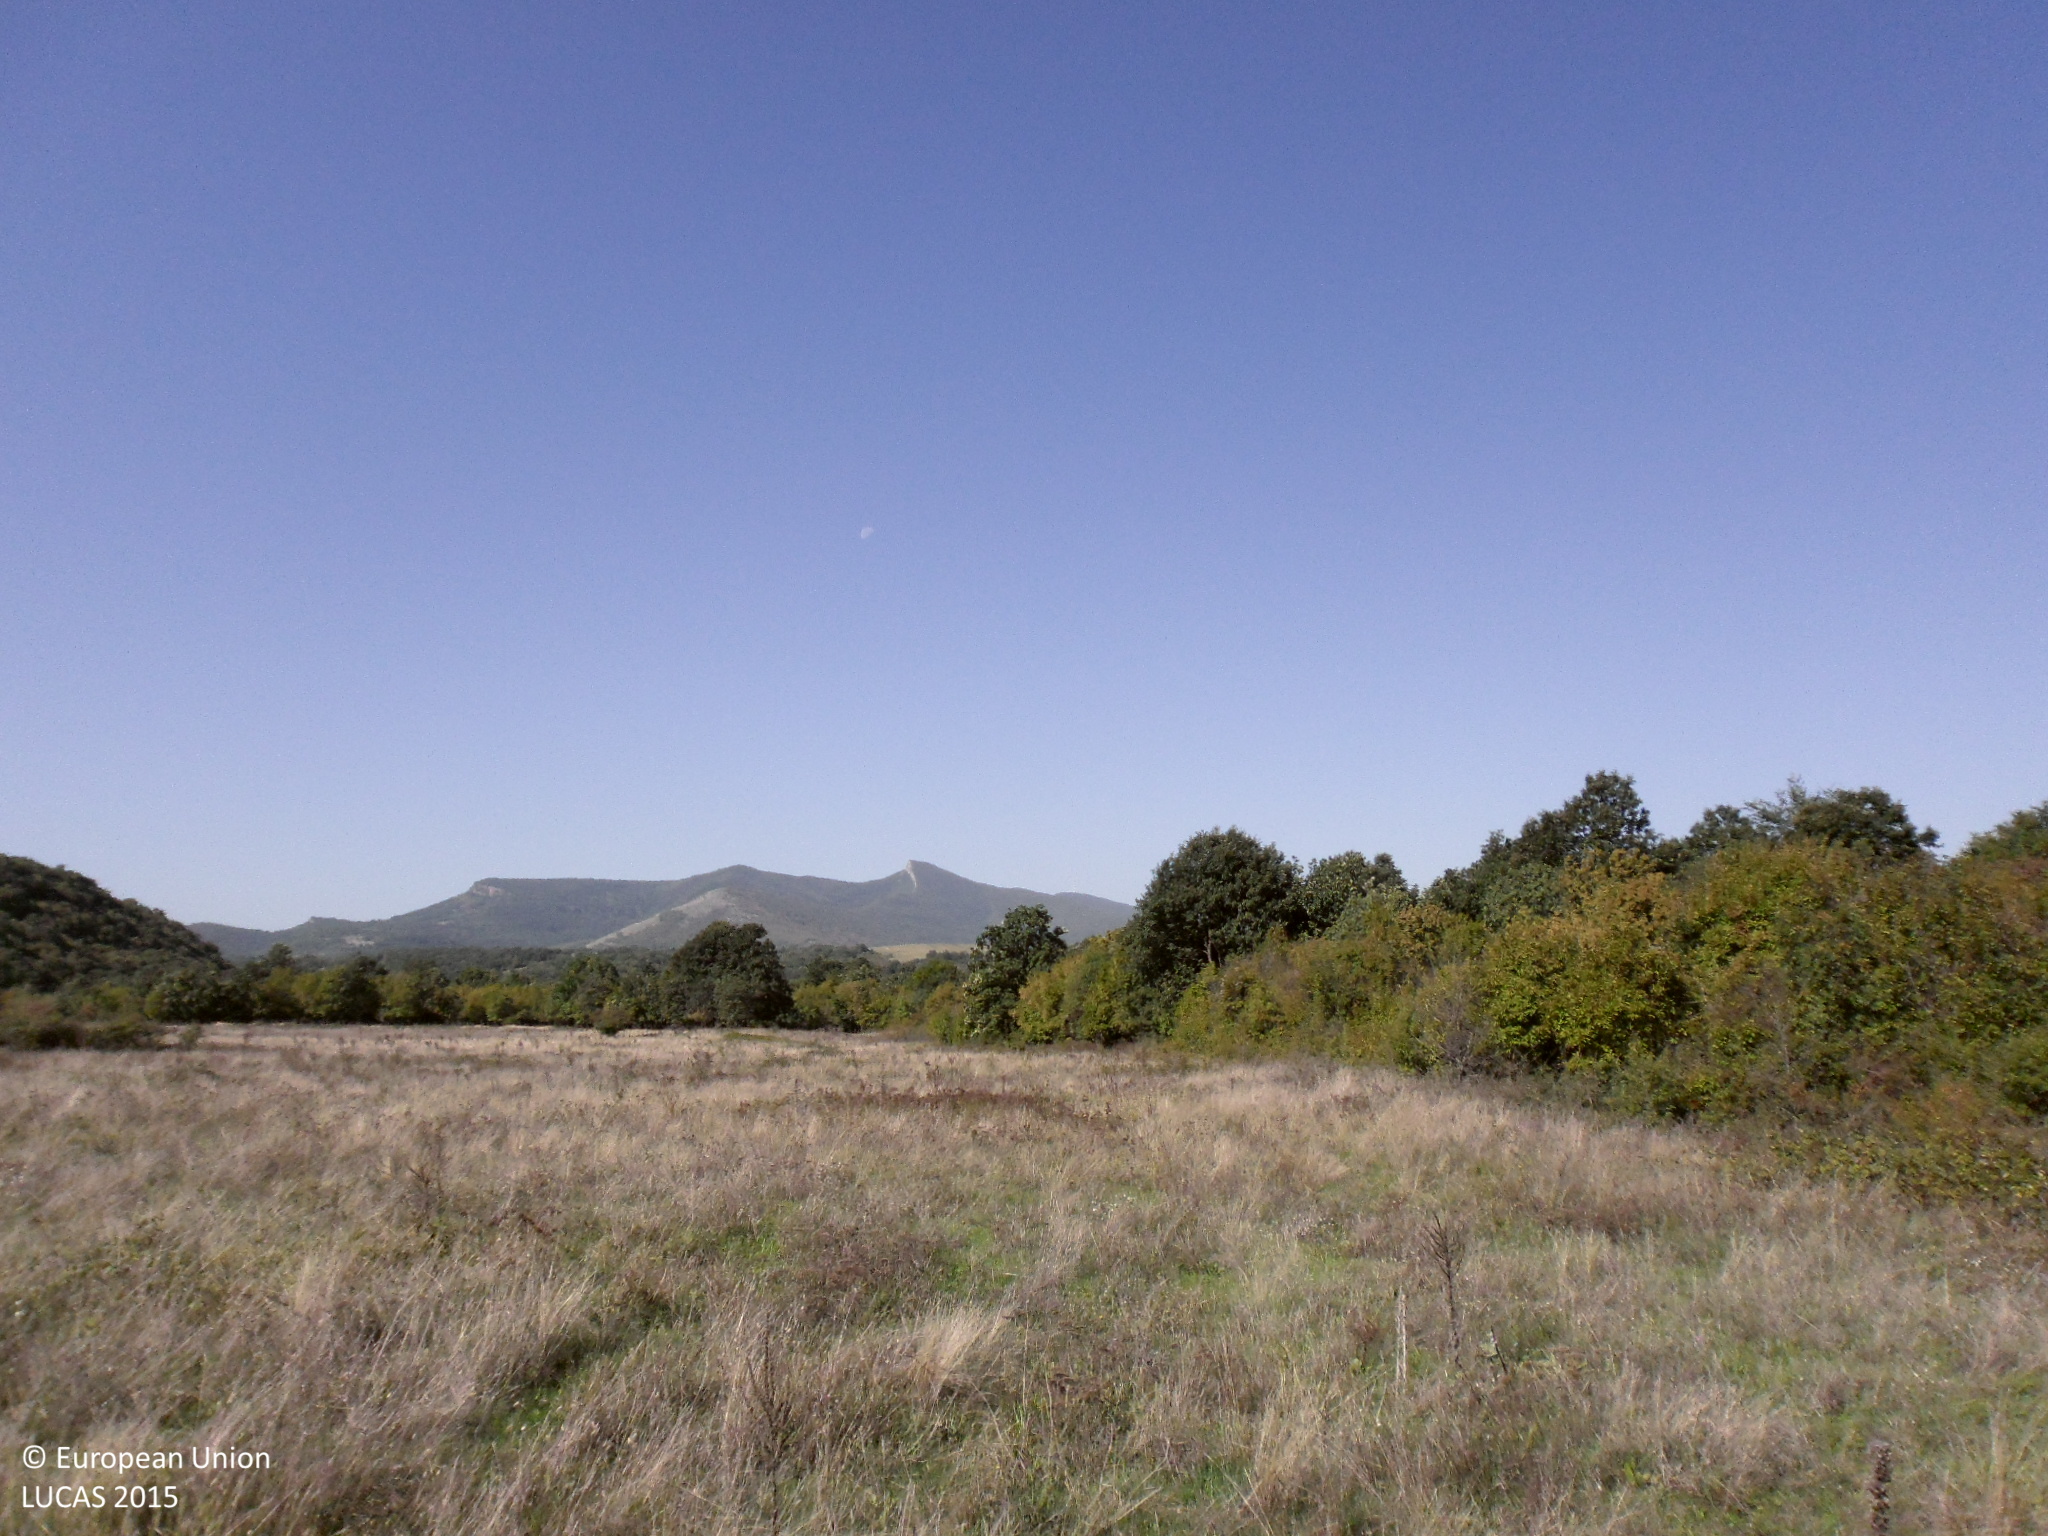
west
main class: Grassland
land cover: Grassland with sparse tree/shrub cover
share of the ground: > 75 %
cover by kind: herbaceous plants 90 %, broadleaved forest trees 5 %, shrubs 5 %
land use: Agriculture (excluding fallow land and kitchen gardens)
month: October
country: BG
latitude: 43.6078
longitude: 22.8090
